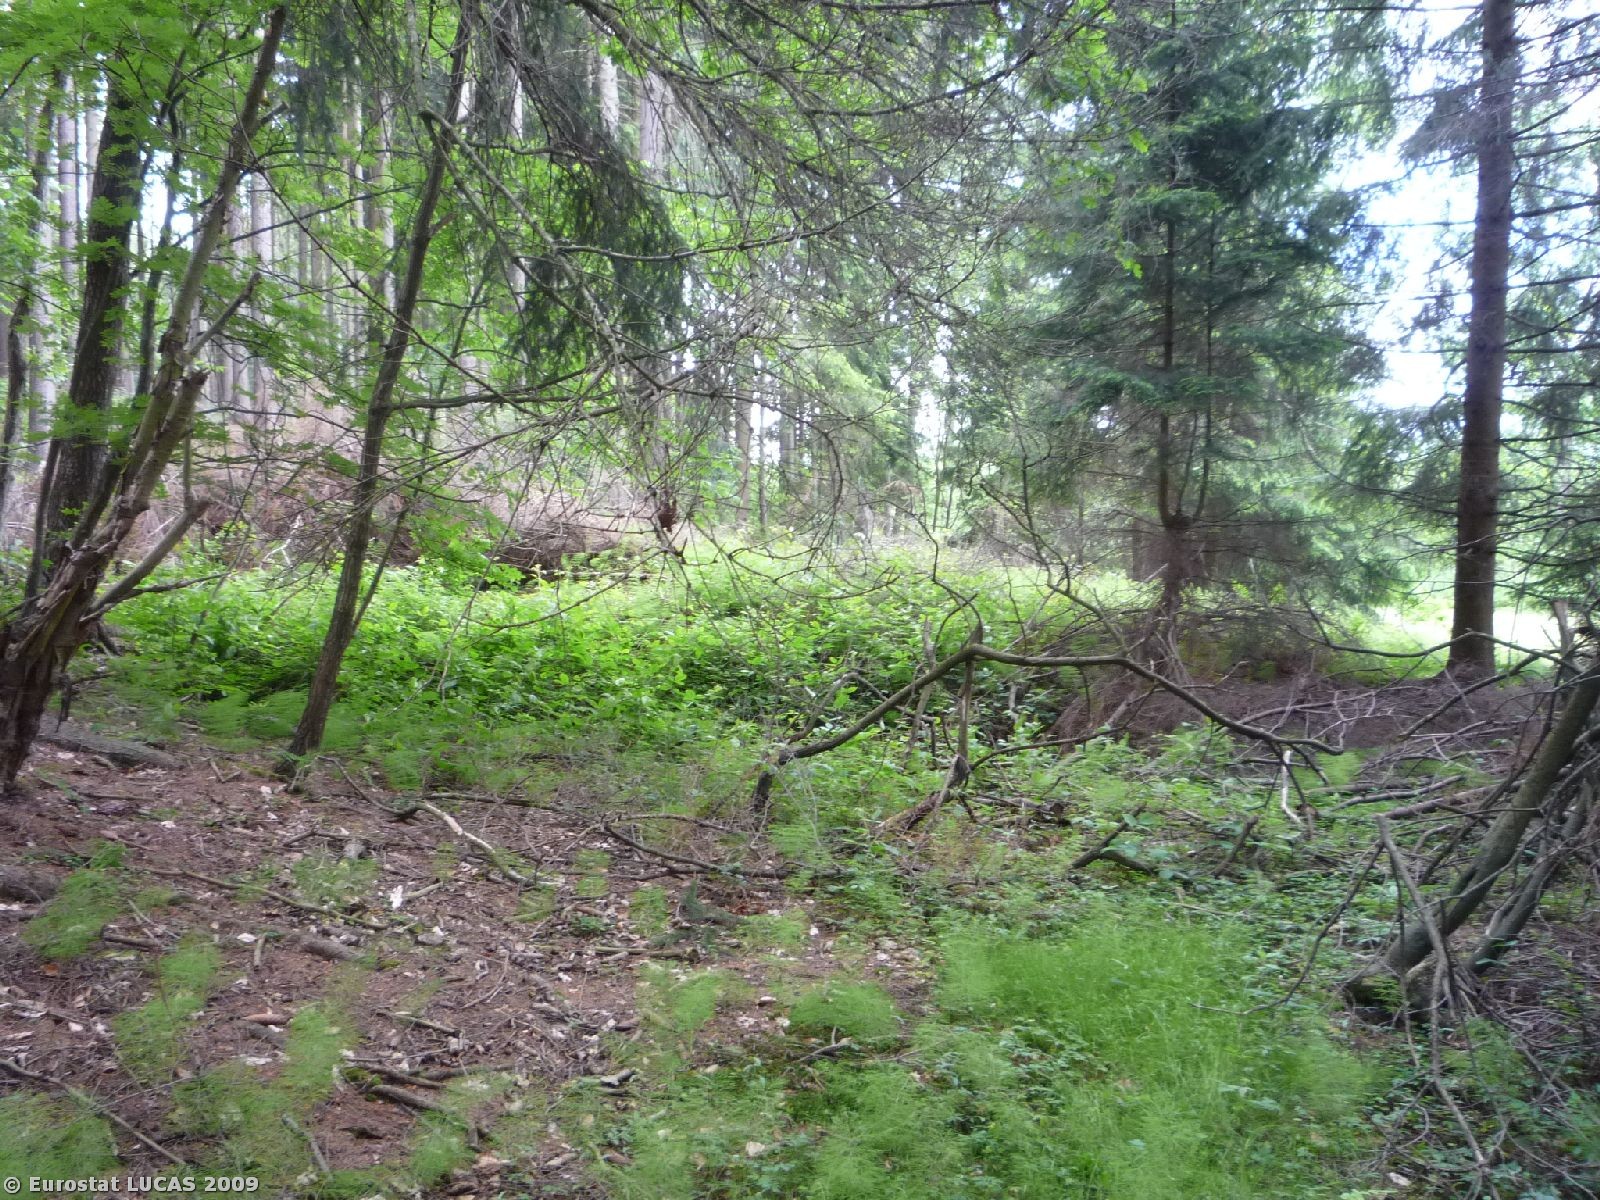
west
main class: Woodland
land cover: Mixed woodland
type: hemiboreal forest and nemoral coniferous forest and mixed broadleaved-coniferous forest
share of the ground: > 75 %
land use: Forestry
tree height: > 5 m
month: June
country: CZ
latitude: 50.4641
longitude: 15.5407
